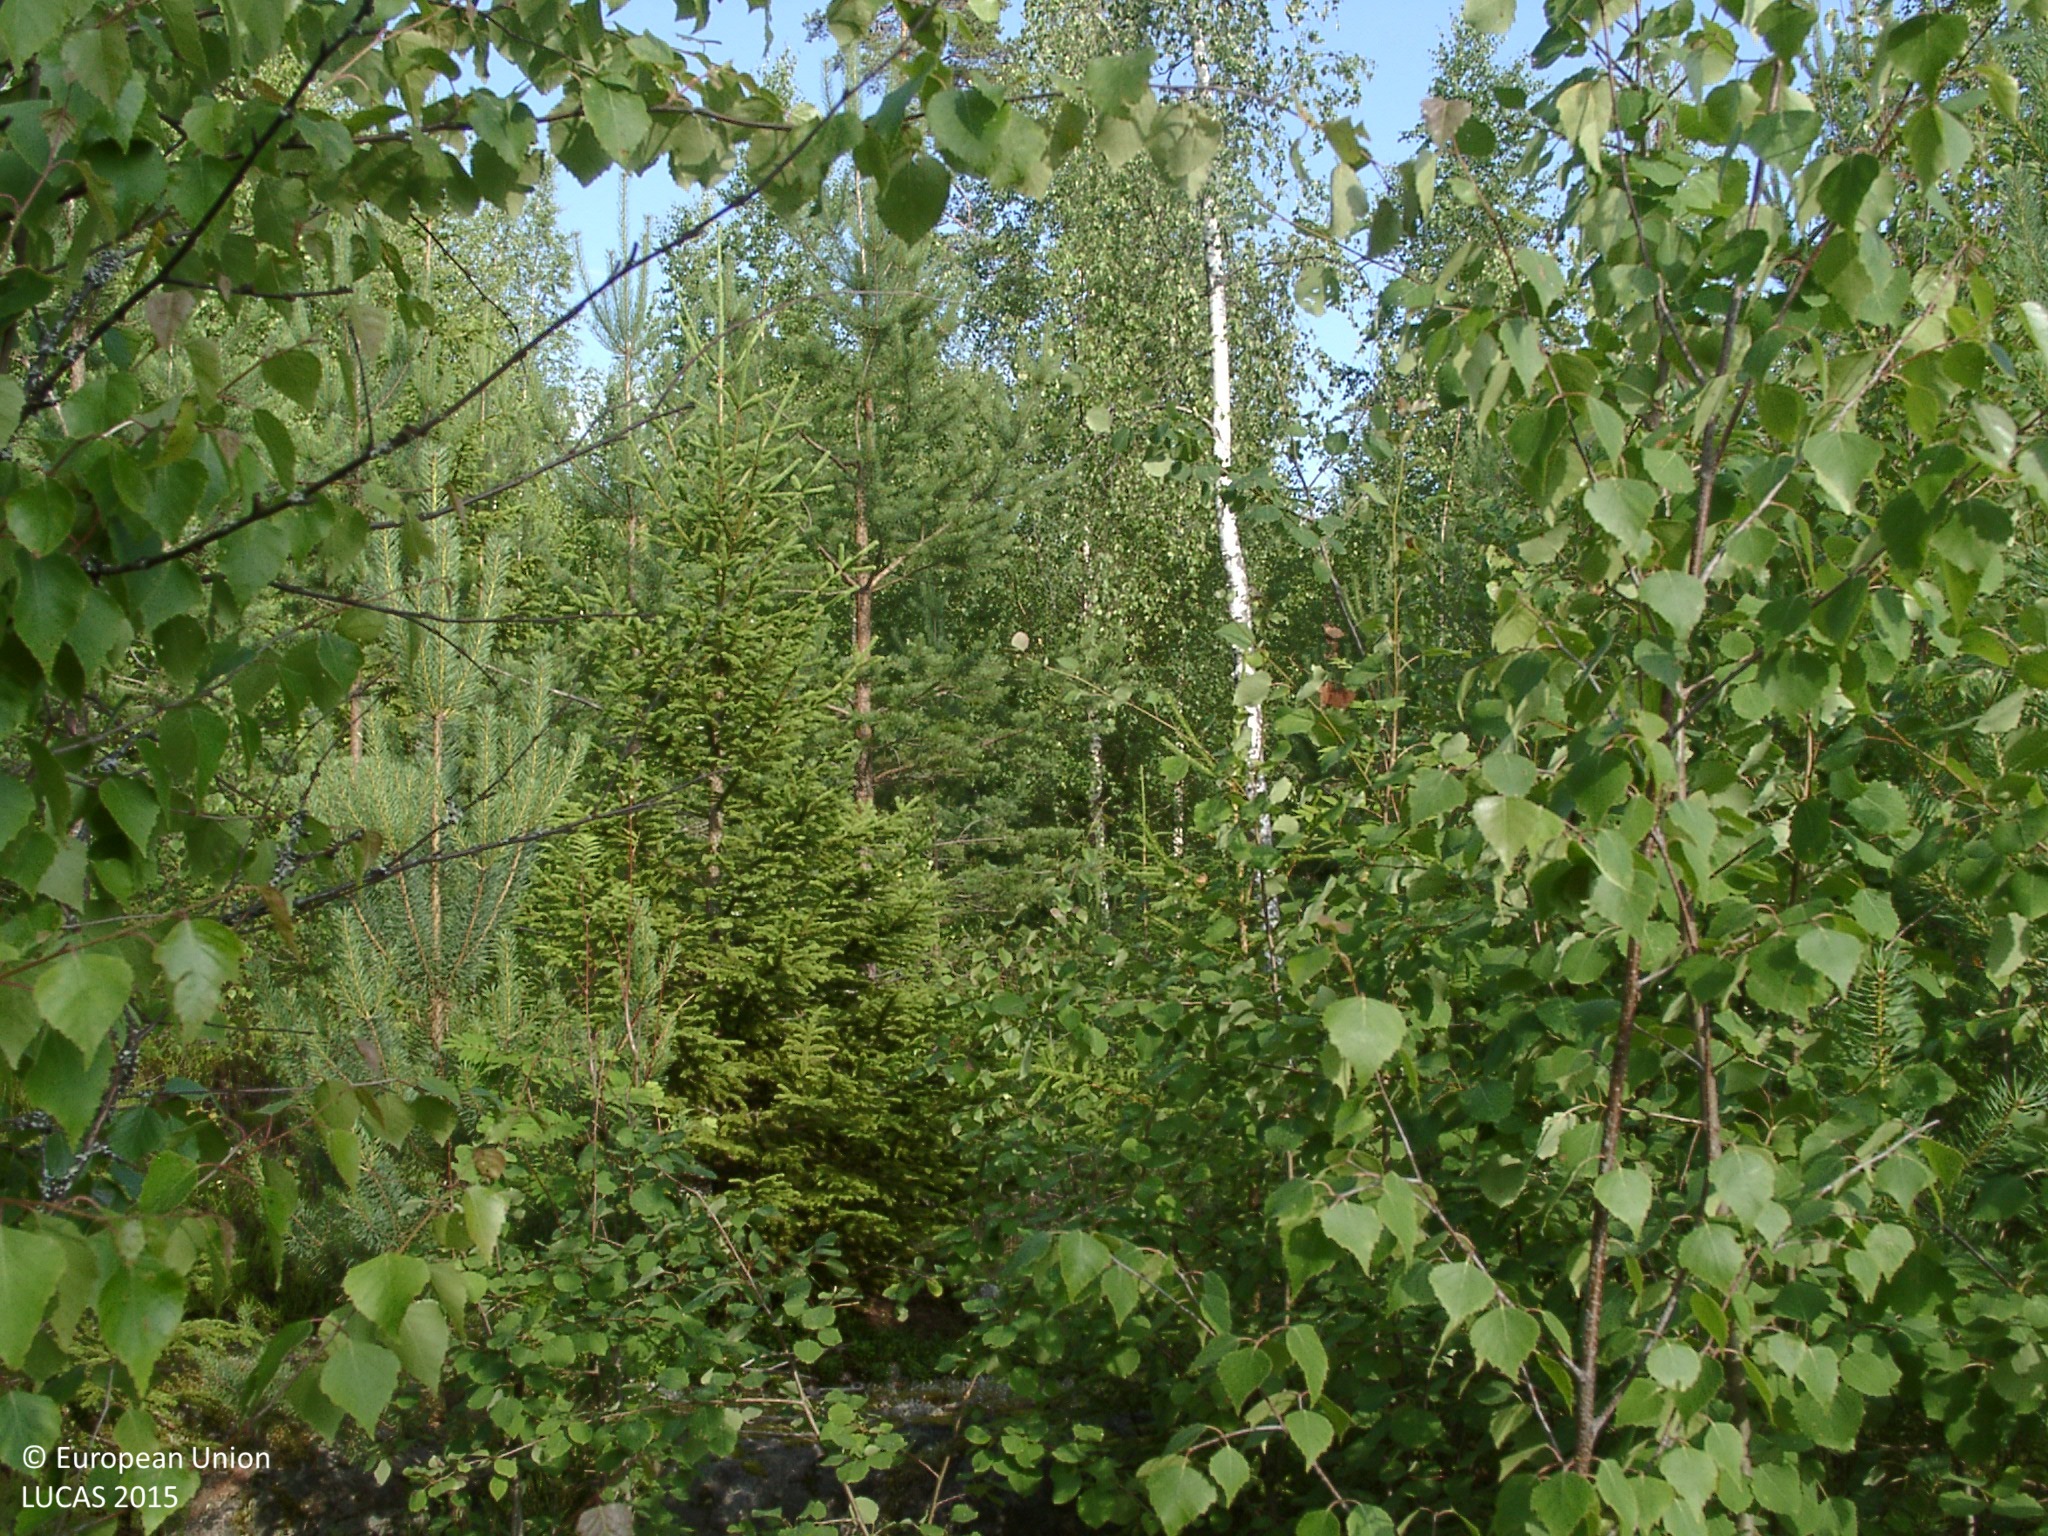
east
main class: Woodland
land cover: Pine dominated mixed woodland
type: boreal forest
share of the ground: 50 - 75 %
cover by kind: broadleaved forest trees 35 %, shrubs 25 %, coniferous forest trees 20 %, lichens and mosses 15 %, consolidated bare surface 5 %
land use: Forestry
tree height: < 5 m
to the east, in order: Pine dominated mixed woodland; Shruby margins; Broadleaved woodland; Ditches and canals; Broadleaved woodland; Pine dominated mixed woodland; Grassland with sparse tree/shrub cover; Shrubland with sparse tree cover; Broadleaved woodland; Pine dominated mixed woodland
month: July
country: FI
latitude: 61.7659
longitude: 24.7875
